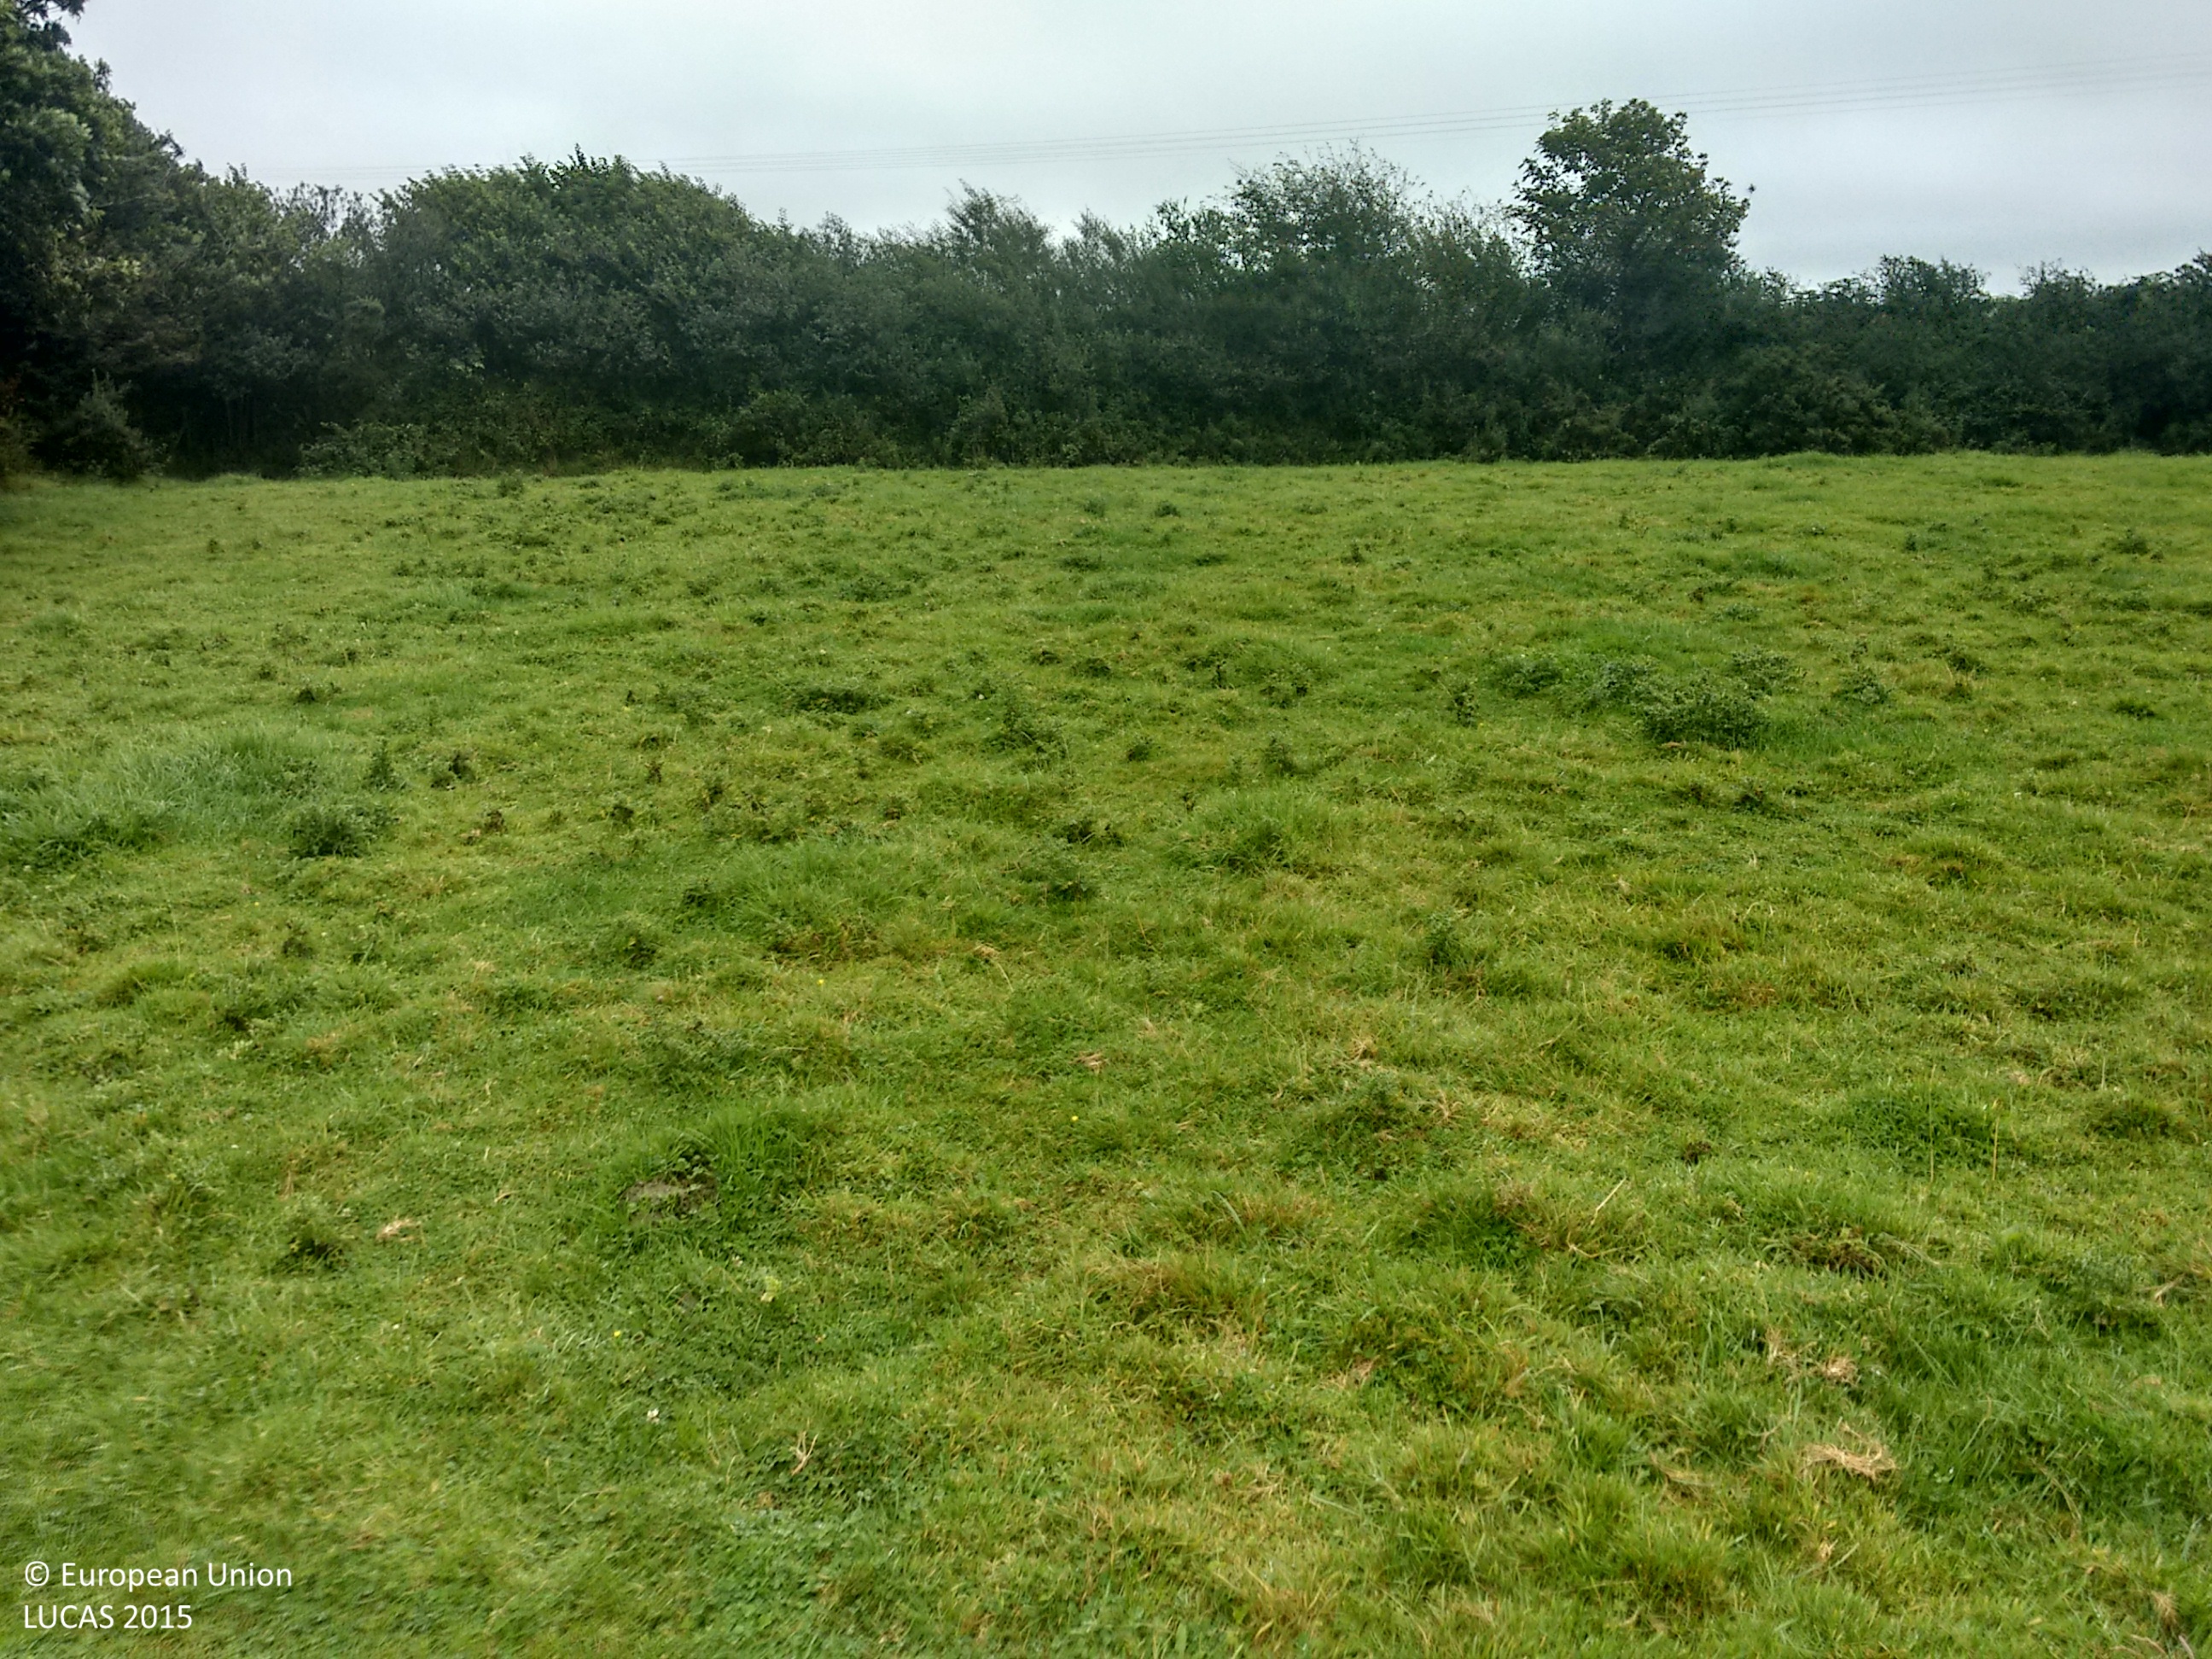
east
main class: Grassland
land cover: Grassland without tree/shrub cover
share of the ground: > 75 %
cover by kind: herbaceous plants 100 %
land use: Agriculture (excluding fallow land and kitchen gardens)
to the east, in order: Grassland without tree/shrub cover; Abandoned hedges; Dry stone walls; Grassland without tree/shrub cover; Electric lines; Grassland without tree/shrub cover; Managed hedges; Paved roads, cycling and walking lanes; Electric lines; Managed hedges; Other fresh vegetables; Managed hedges; Grass margins; Paved roads, cycling and walking lanes; Grassland without tree/shrub cover
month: August
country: GB
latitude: 50.0803
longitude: -5.1411
